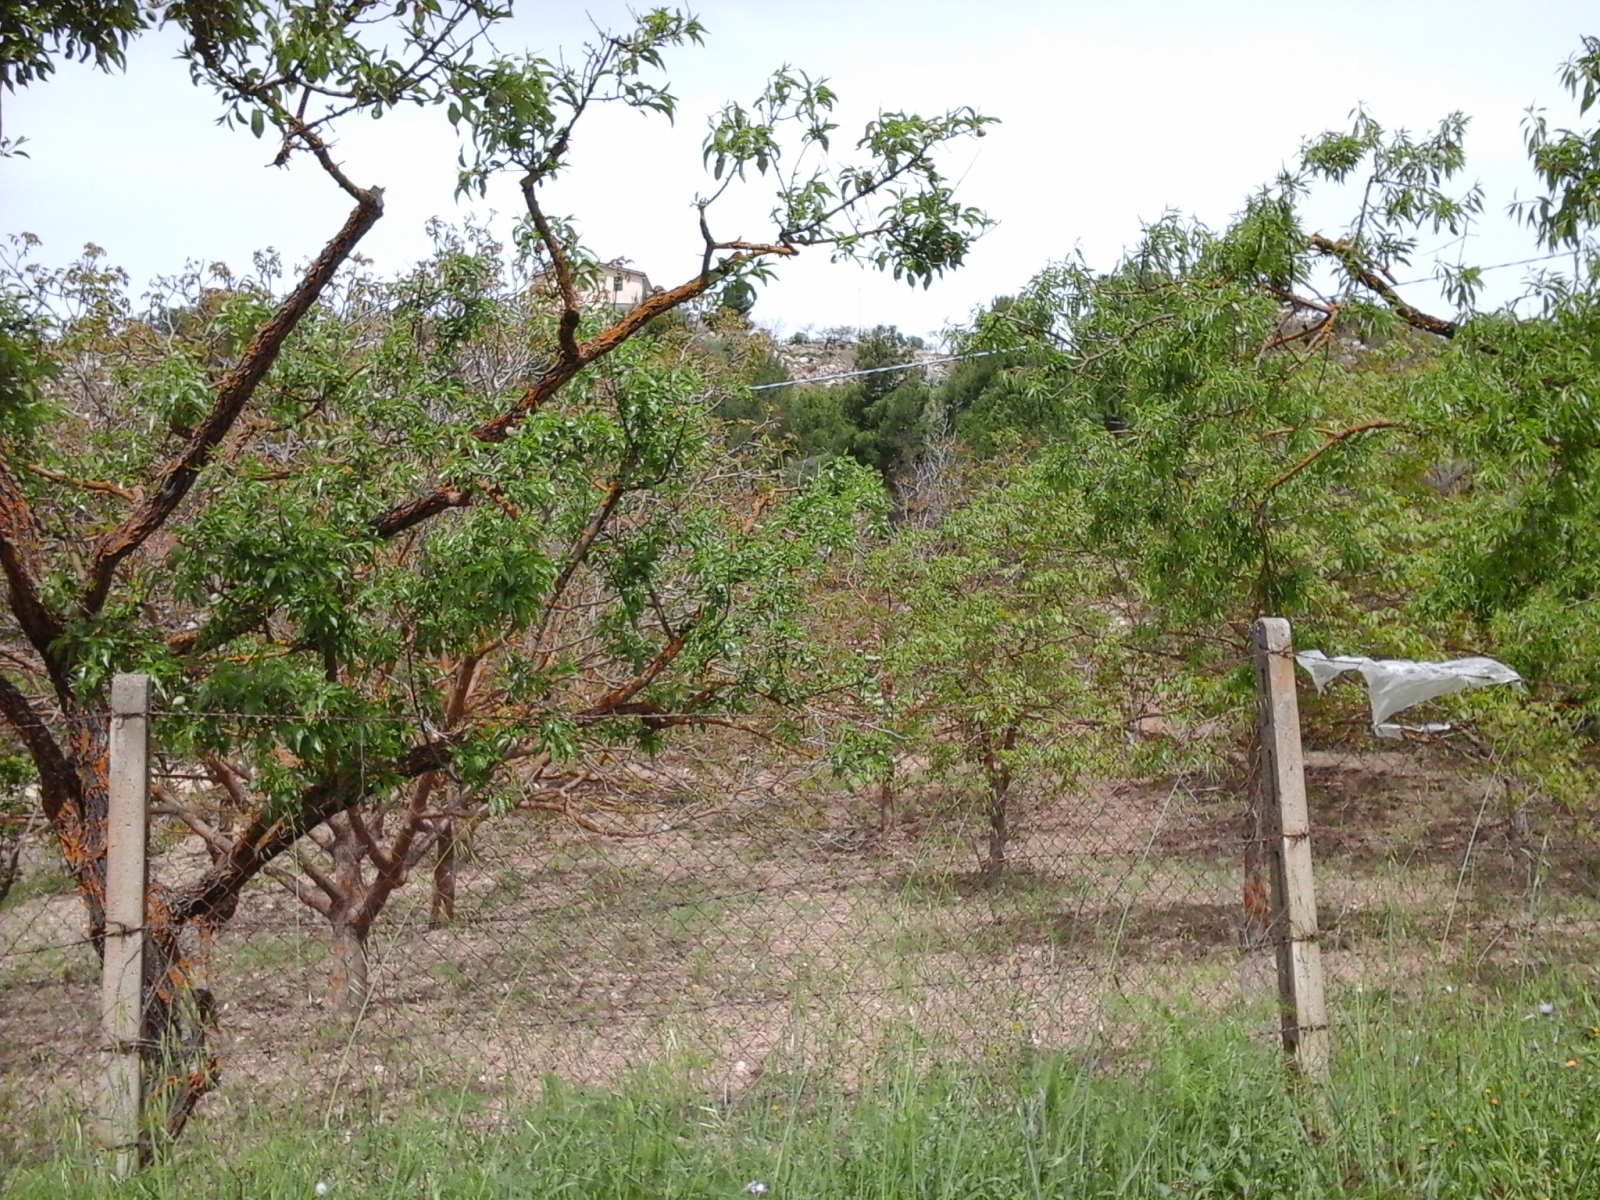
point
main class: Cropland
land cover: Nuts trees
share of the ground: > 75 %
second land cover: Other bare soil
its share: > 75 %
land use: Agriculture (excluding fallow land and kitchen gardens)
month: May
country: IT
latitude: 37.4040
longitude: 14.1149
